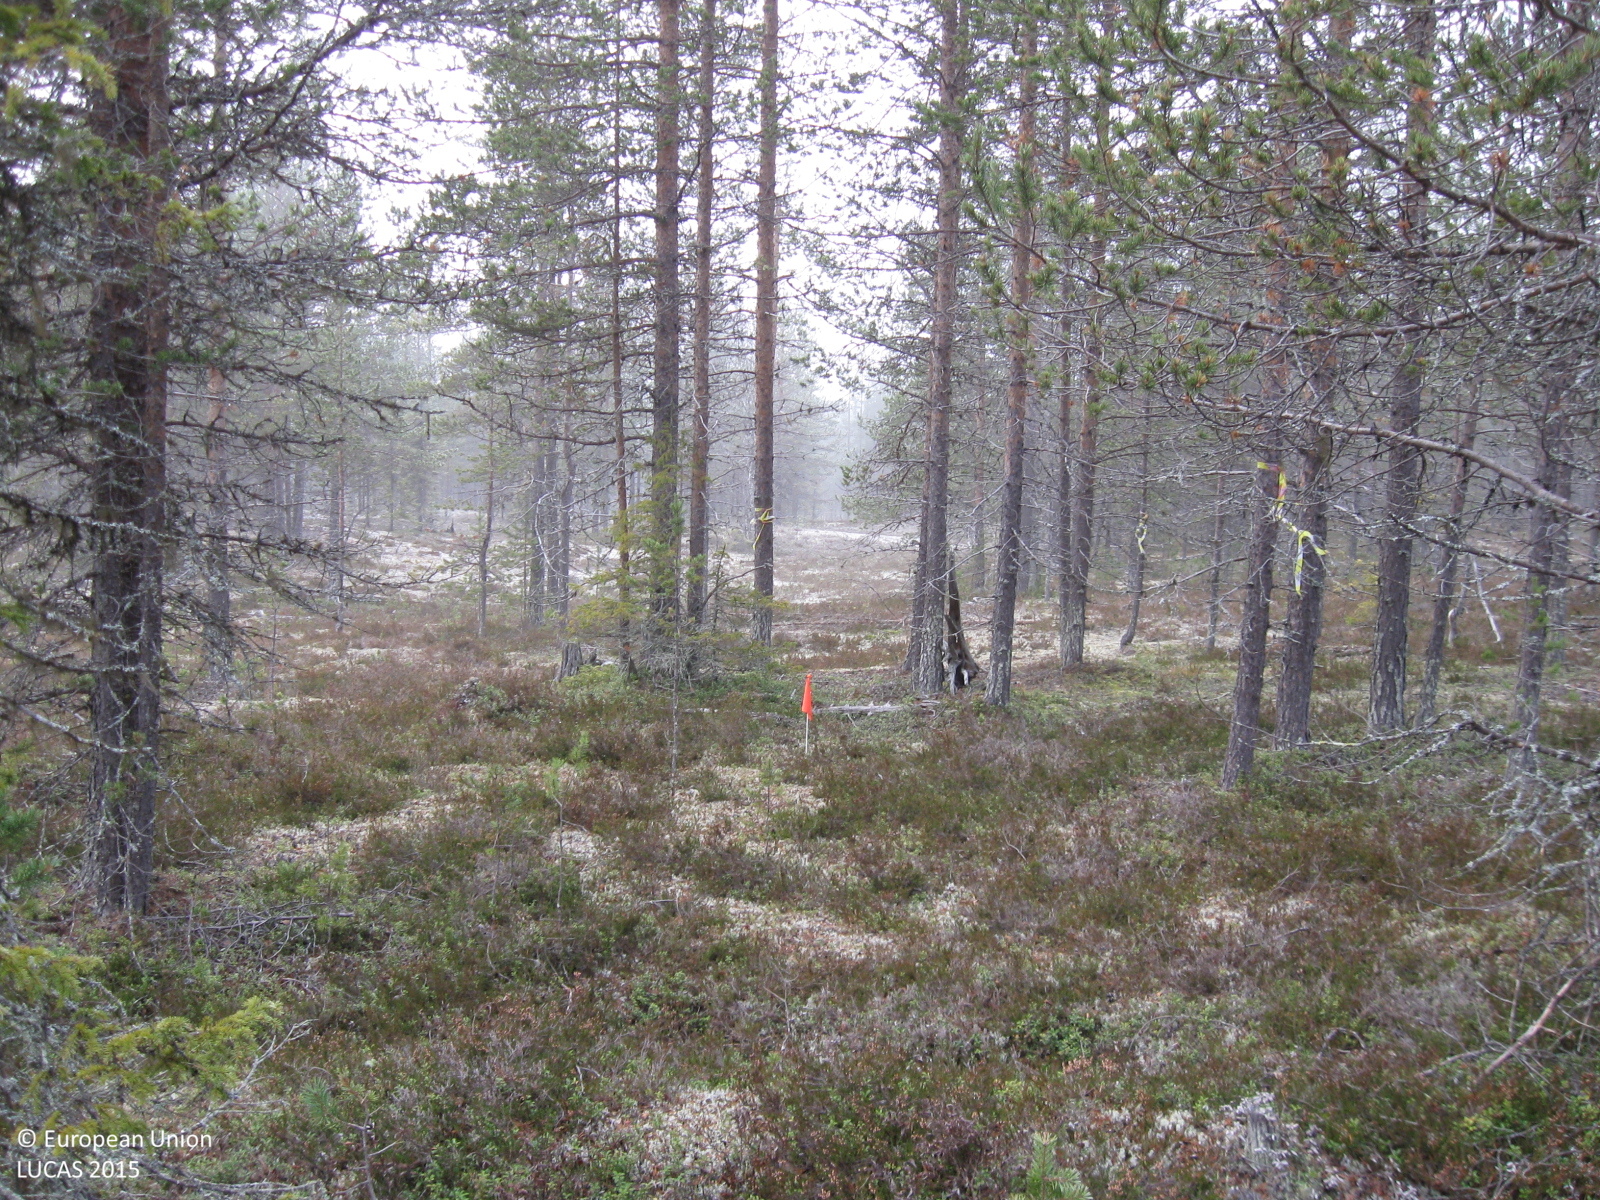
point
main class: Woodland
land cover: Pine dominated coniferous woodland
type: boreal forest
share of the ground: 50 - 75 %
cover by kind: coniferous forest trees 60 %, shrubs 15 %, herbaceous plants 10 %, lichens and mosses 10 %, consolidated bare surface 5 %
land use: Forestry
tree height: > 5 m
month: October
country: SE
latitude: 66.3813
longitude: 21.7087
